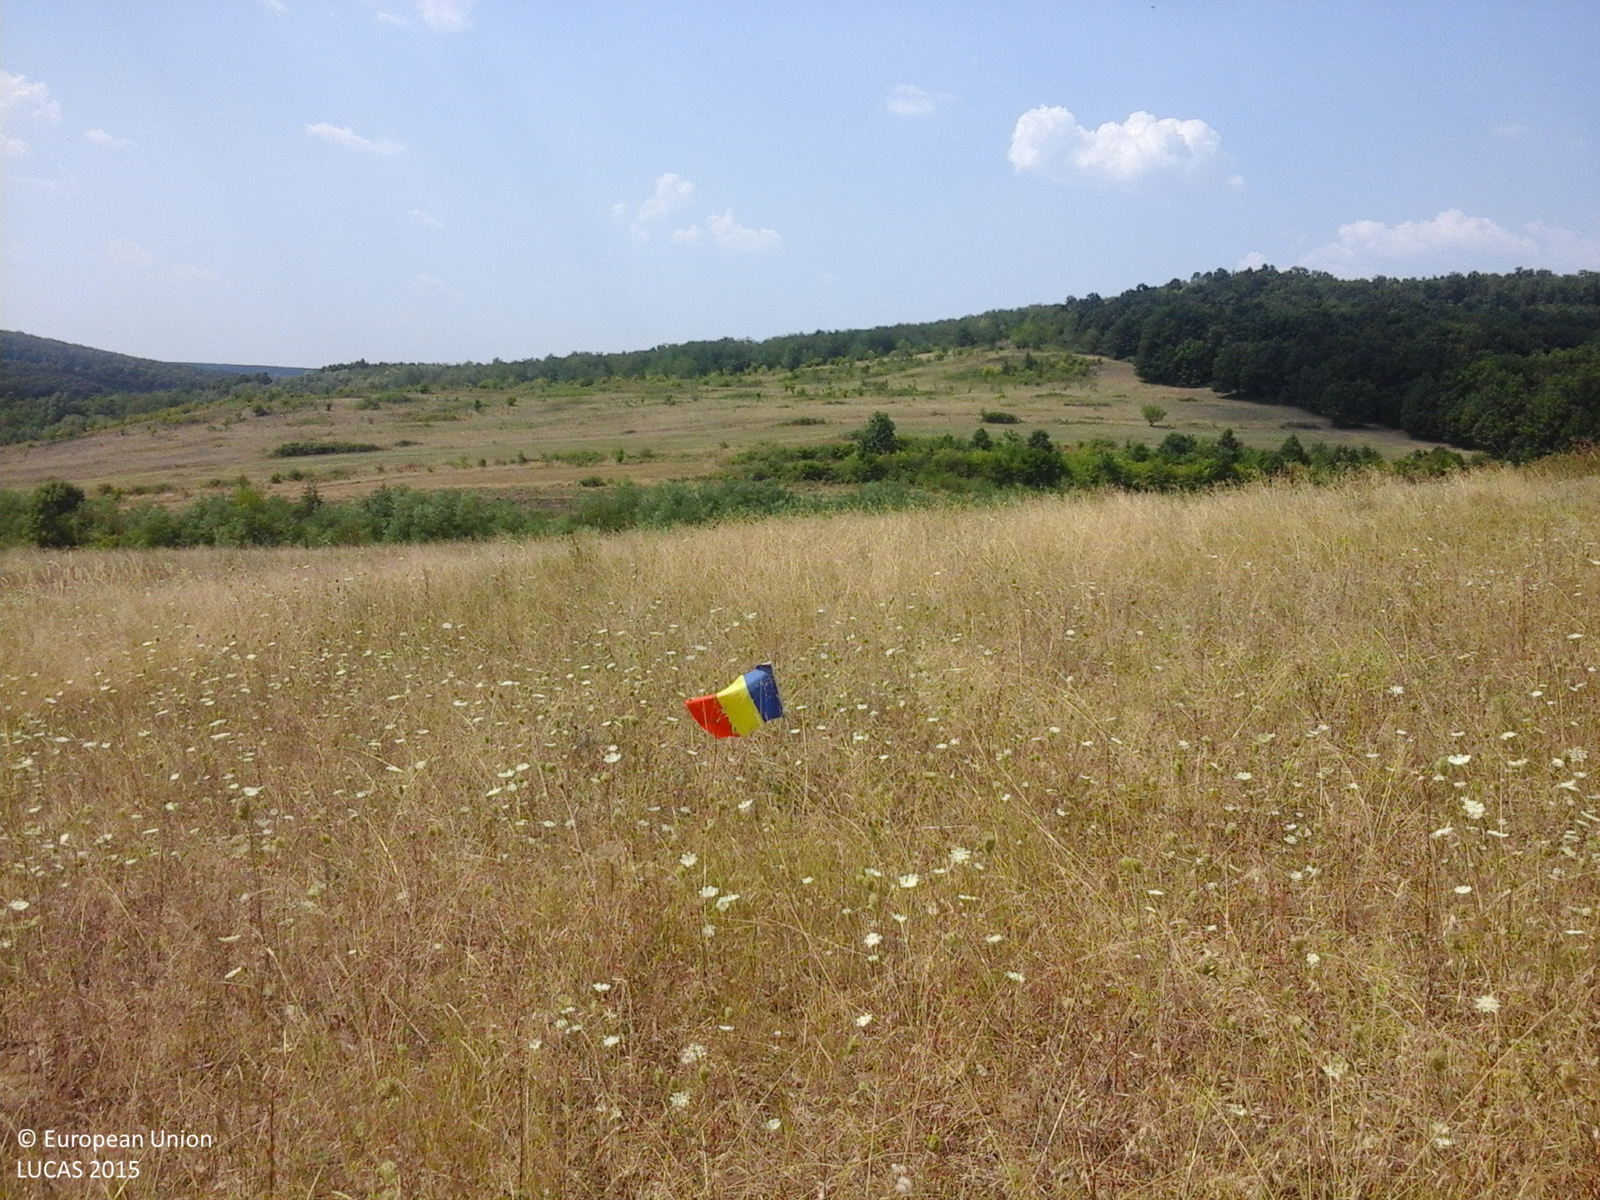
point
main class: Grassland
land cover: Spontaneously vegetated surfaces
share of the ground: > 75 %
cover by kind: herbaceous plants 100 %
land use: Fallow land
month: August
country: RO
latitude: 44.5130
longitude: 23.2966
